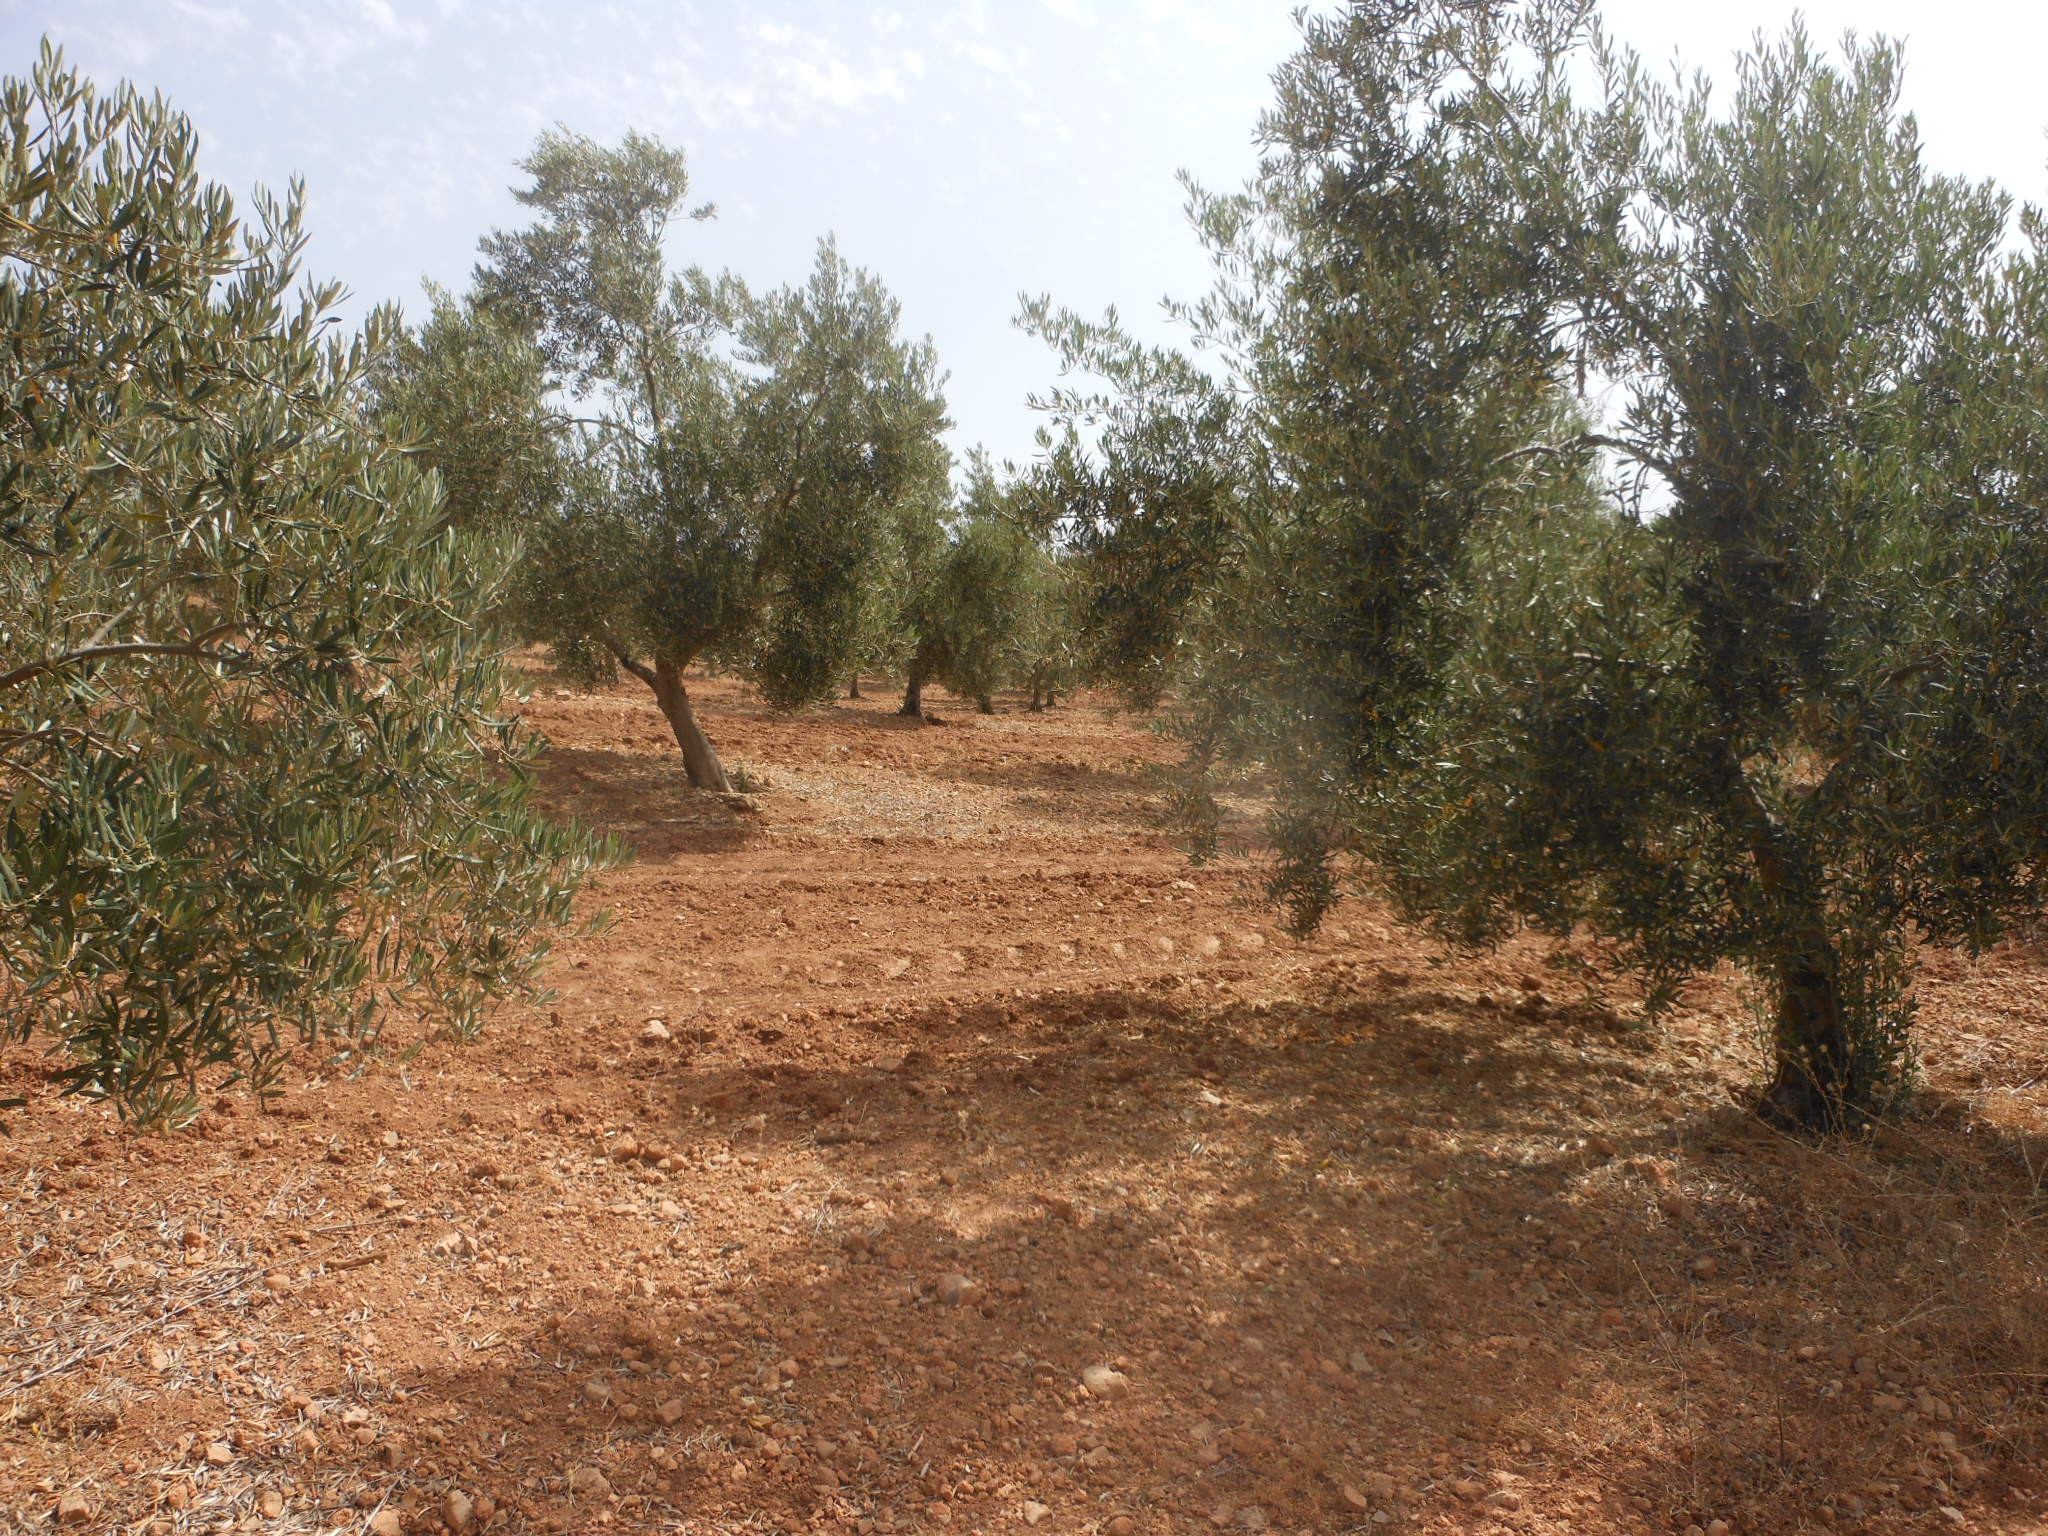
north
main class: Cropland
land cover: Olive groves
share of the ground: 10 - 25 %
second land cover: Other bare soil
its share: > 75 %
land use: Agriculture (excluding fallow land and kitchen gardens)
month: June
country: ES
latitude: 37.1911
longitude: -5.0222
